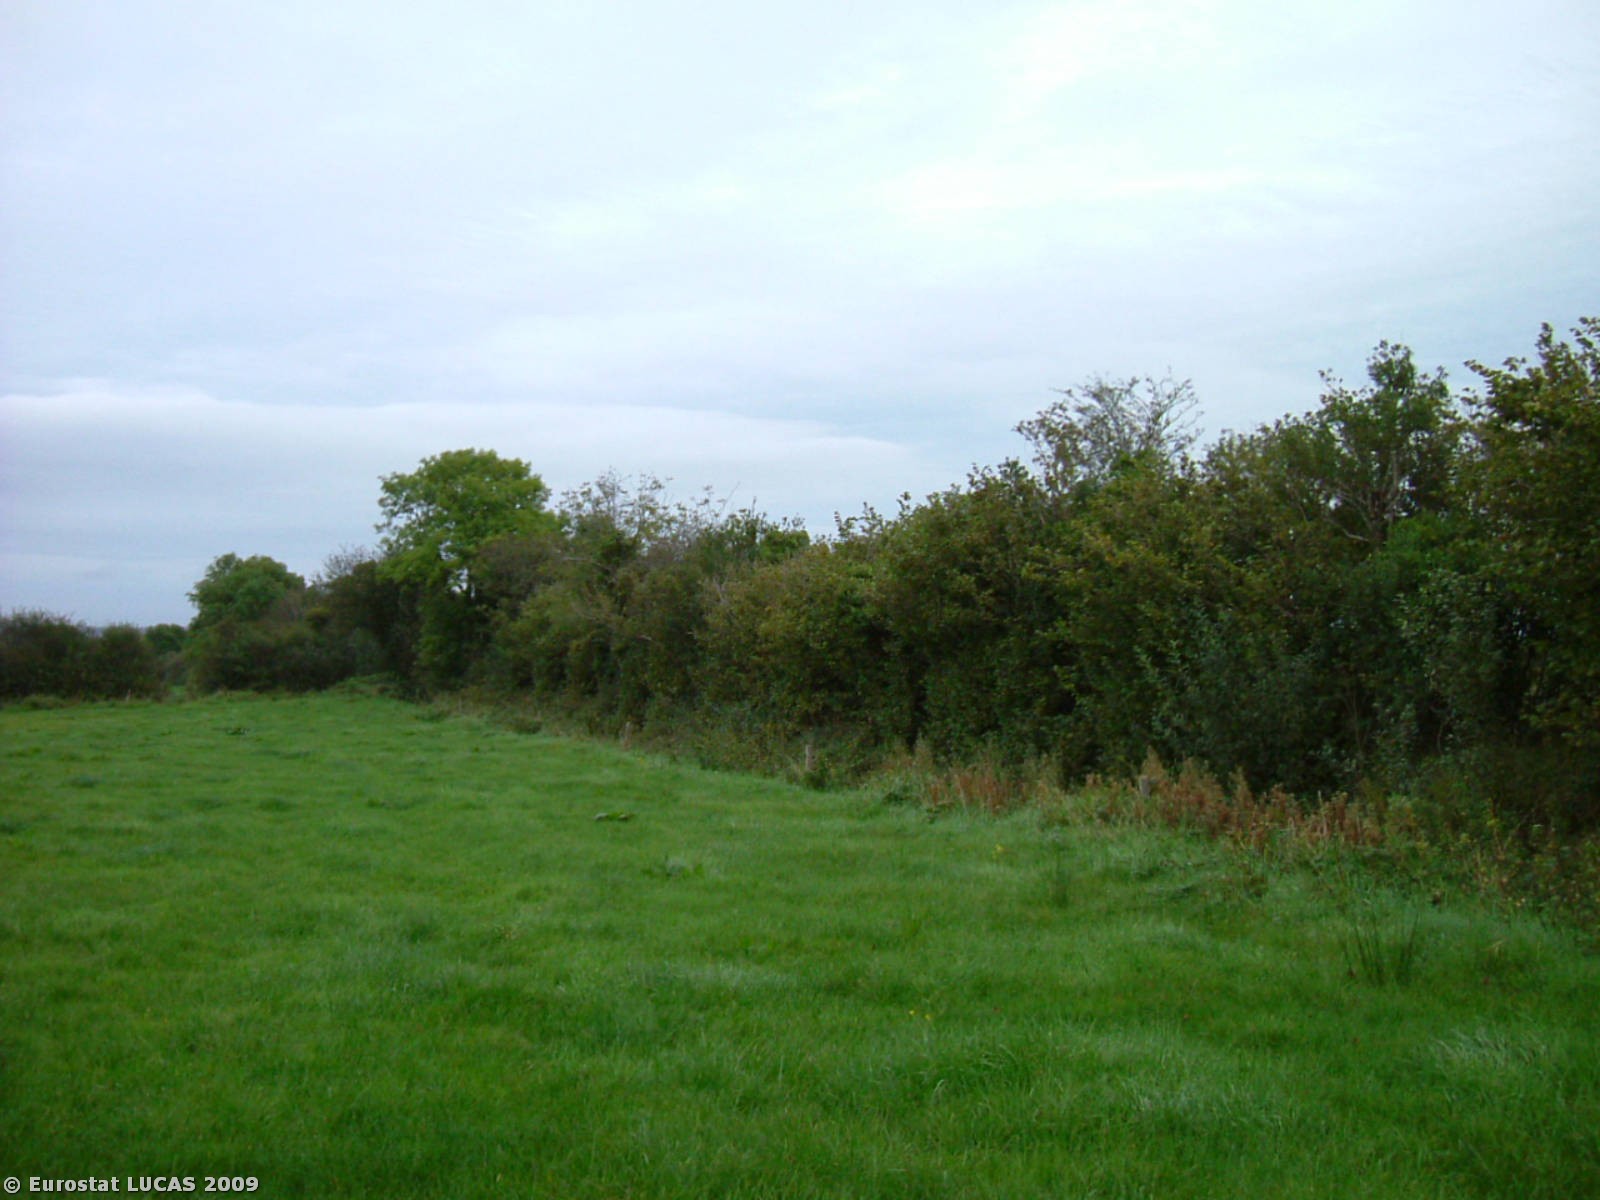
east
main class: Grassland
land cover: Grassland without tree/shrub cover
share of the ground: > 75 %
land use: Agriculture (excluding fallow land and kitchen gardens)
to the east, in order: Grassland without tree/shrub cover; Ditches and canals; Managed hedges; Grassland without tree/shrub cover
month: September
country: IE
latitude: 52.8906
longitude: -7.8424
